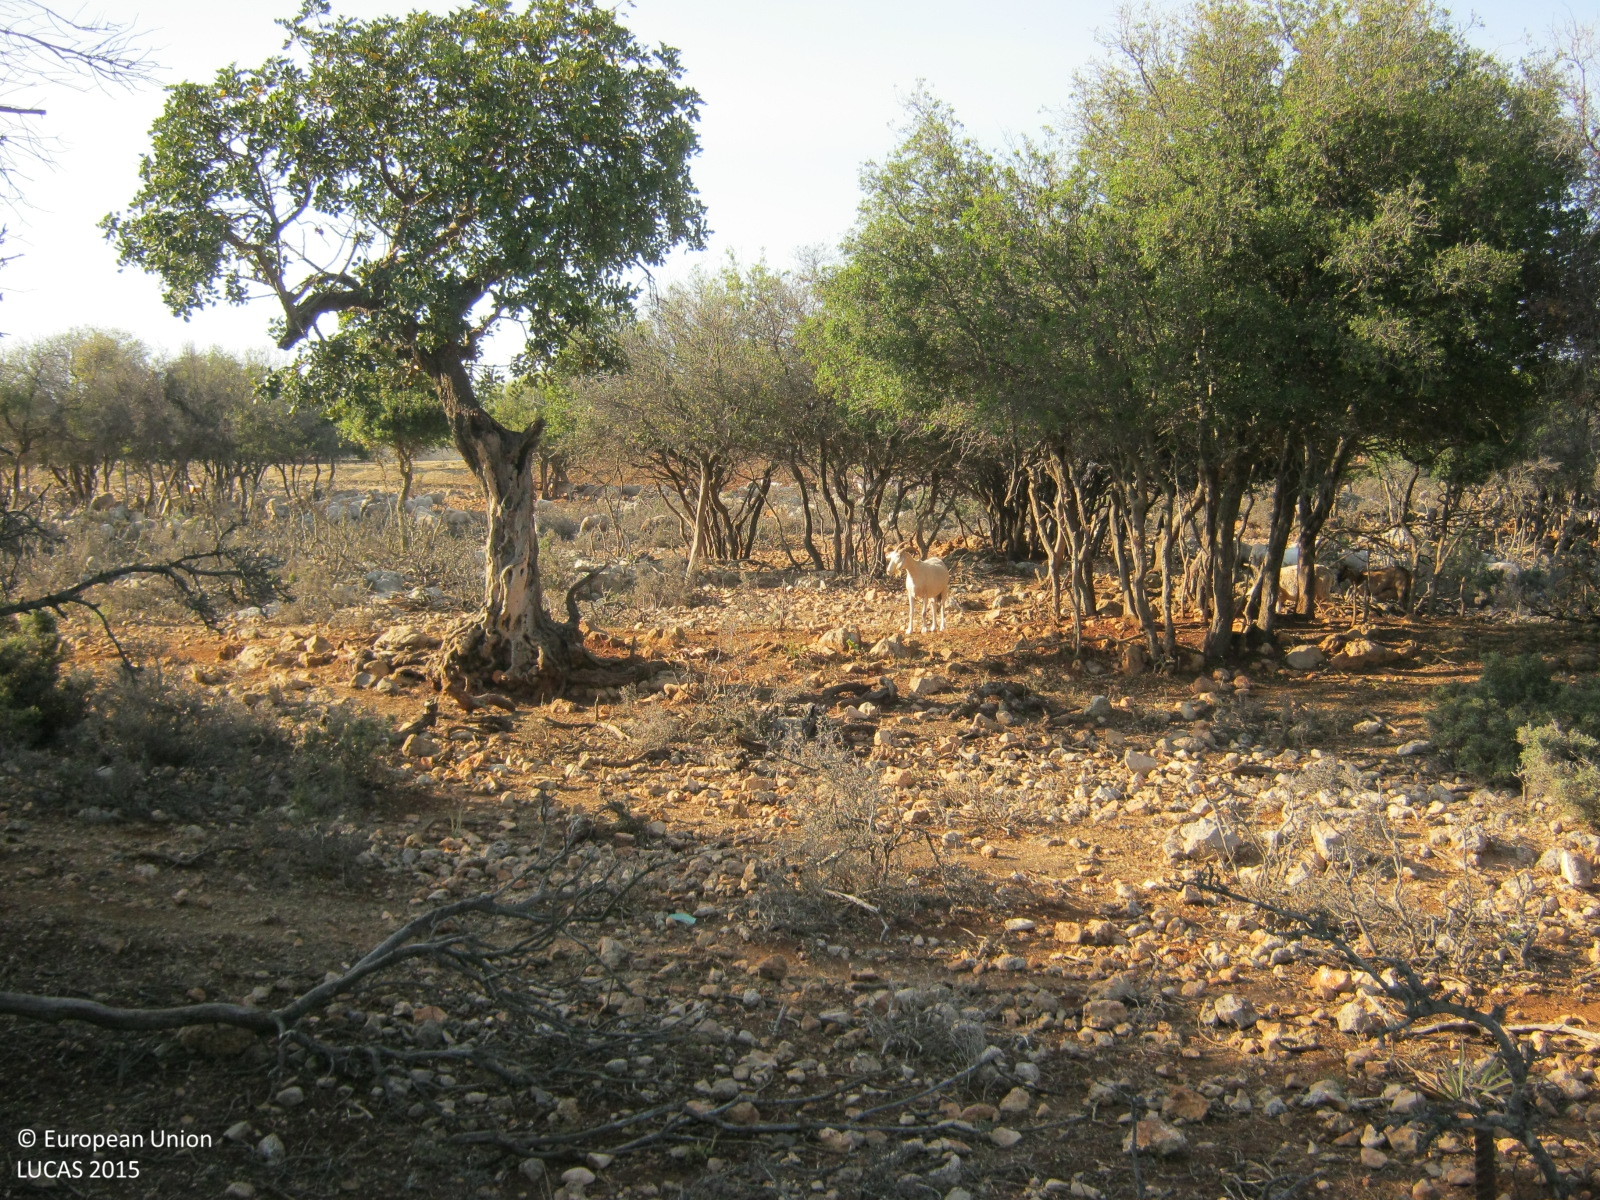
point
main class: Shrubland
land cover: Shrubland with sparse tree cover
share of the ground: 25 - 50 %
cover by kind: unconsolidated bare surface 60 %, shrubs 30 %, broadleaved forest trees 5 %, herbaceous plants 5 %
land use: Agriculture (excluding fallow land and kitchen gardens)
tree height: < 5 m
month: June
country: GR
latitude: 35.3709
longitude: 24.6610
